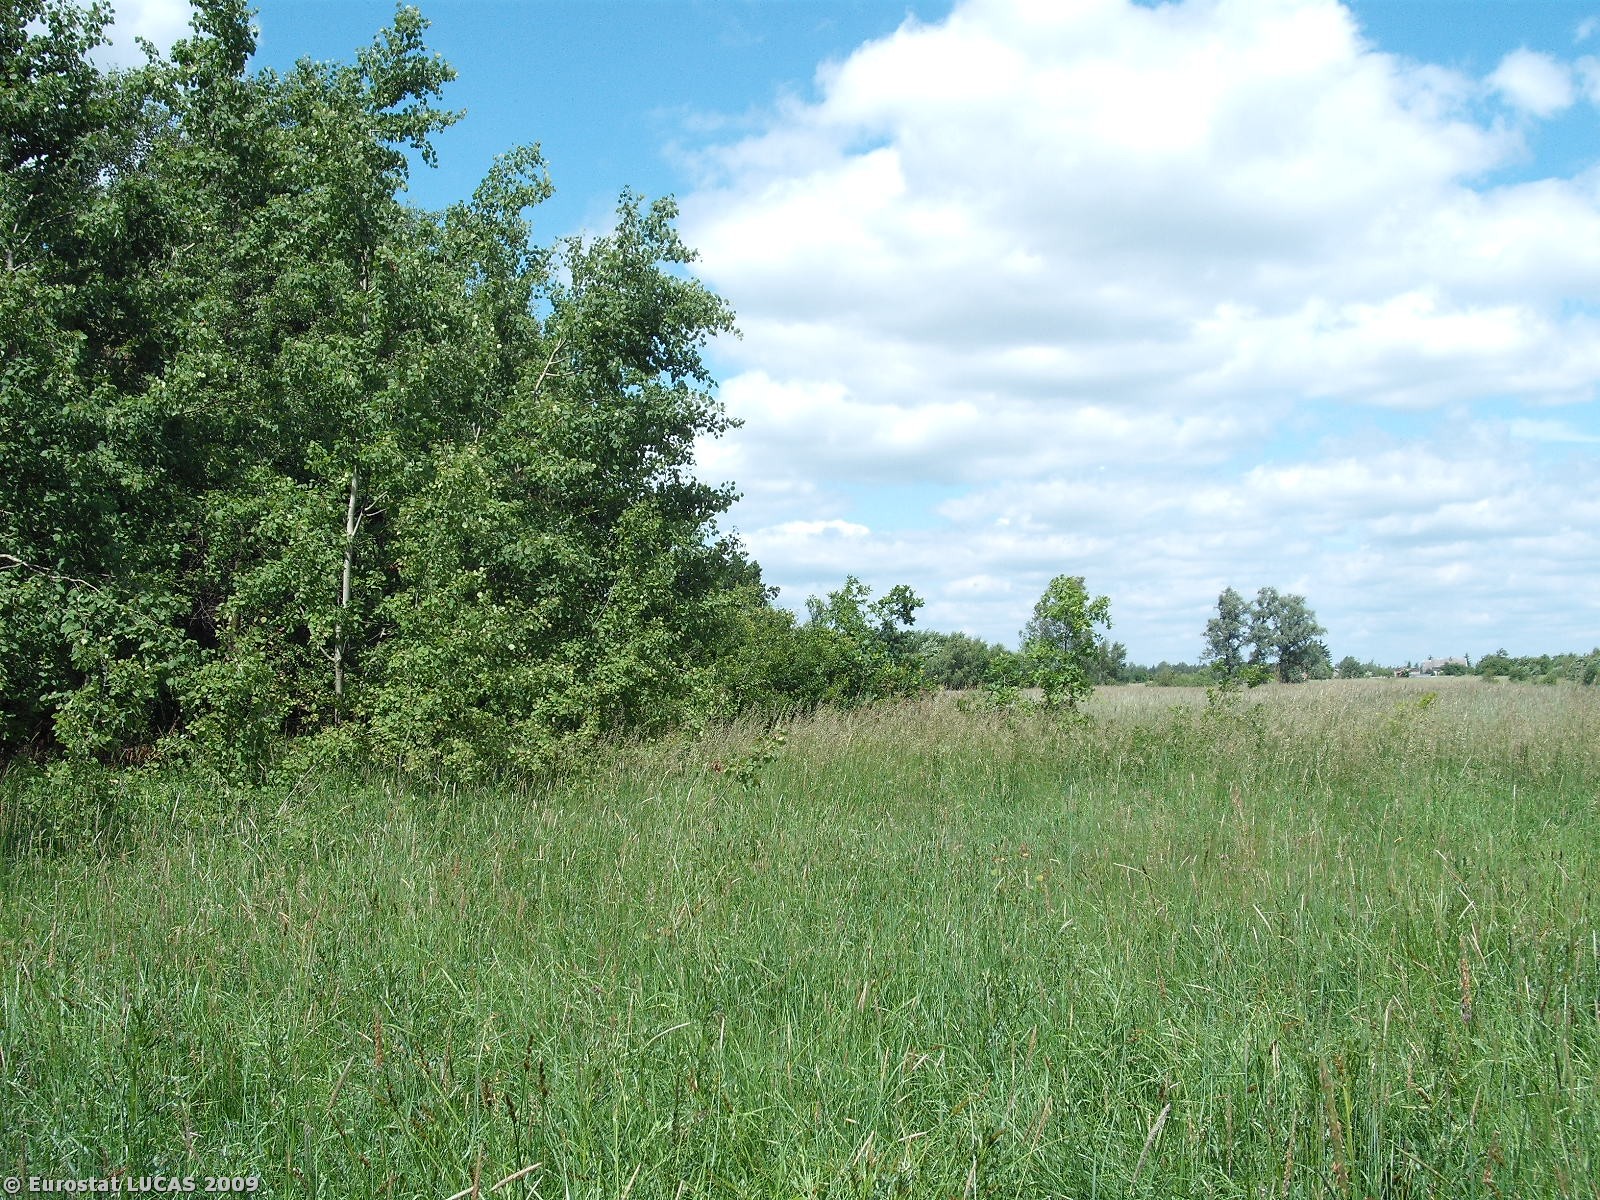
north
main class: Grassland
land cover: Grassland with sparse tree/shrub cover
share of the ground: > 75 %
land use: Unused
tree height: < 5 m
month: June
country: PL
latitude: 51.3562
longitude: 21.0014
